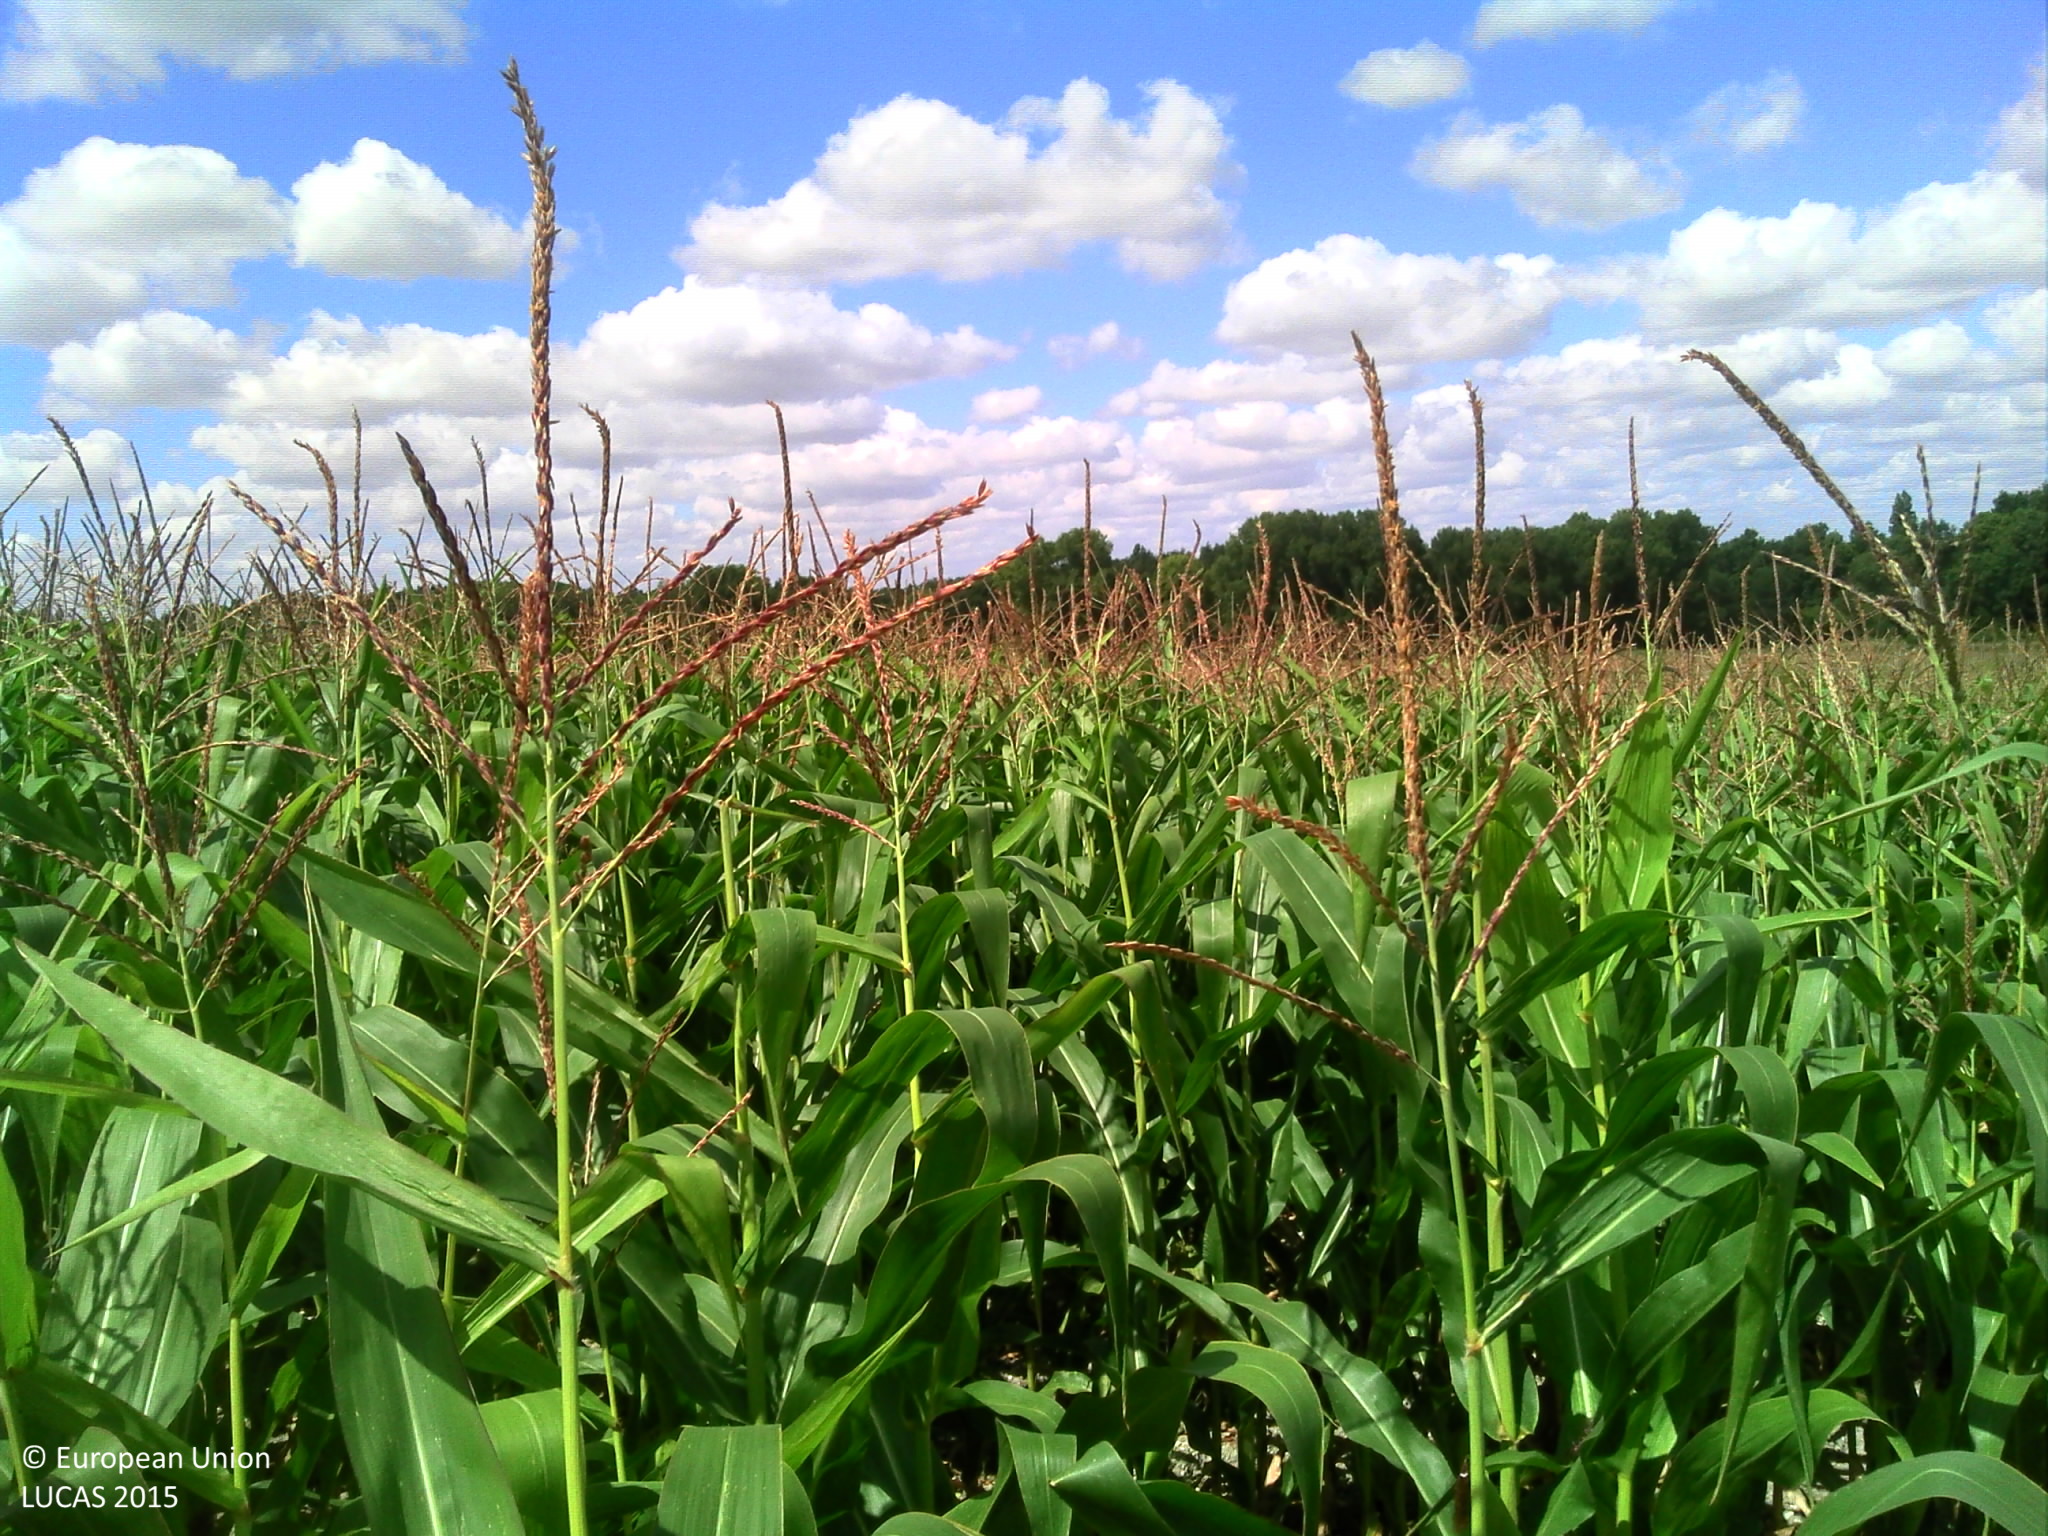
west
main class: Cropland
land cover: Maize
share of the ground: > 75 %
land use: Agriculture (excluding fallow land and kitchen gardens)
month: July
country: FR
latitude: 47.0257
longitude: 0.4142
